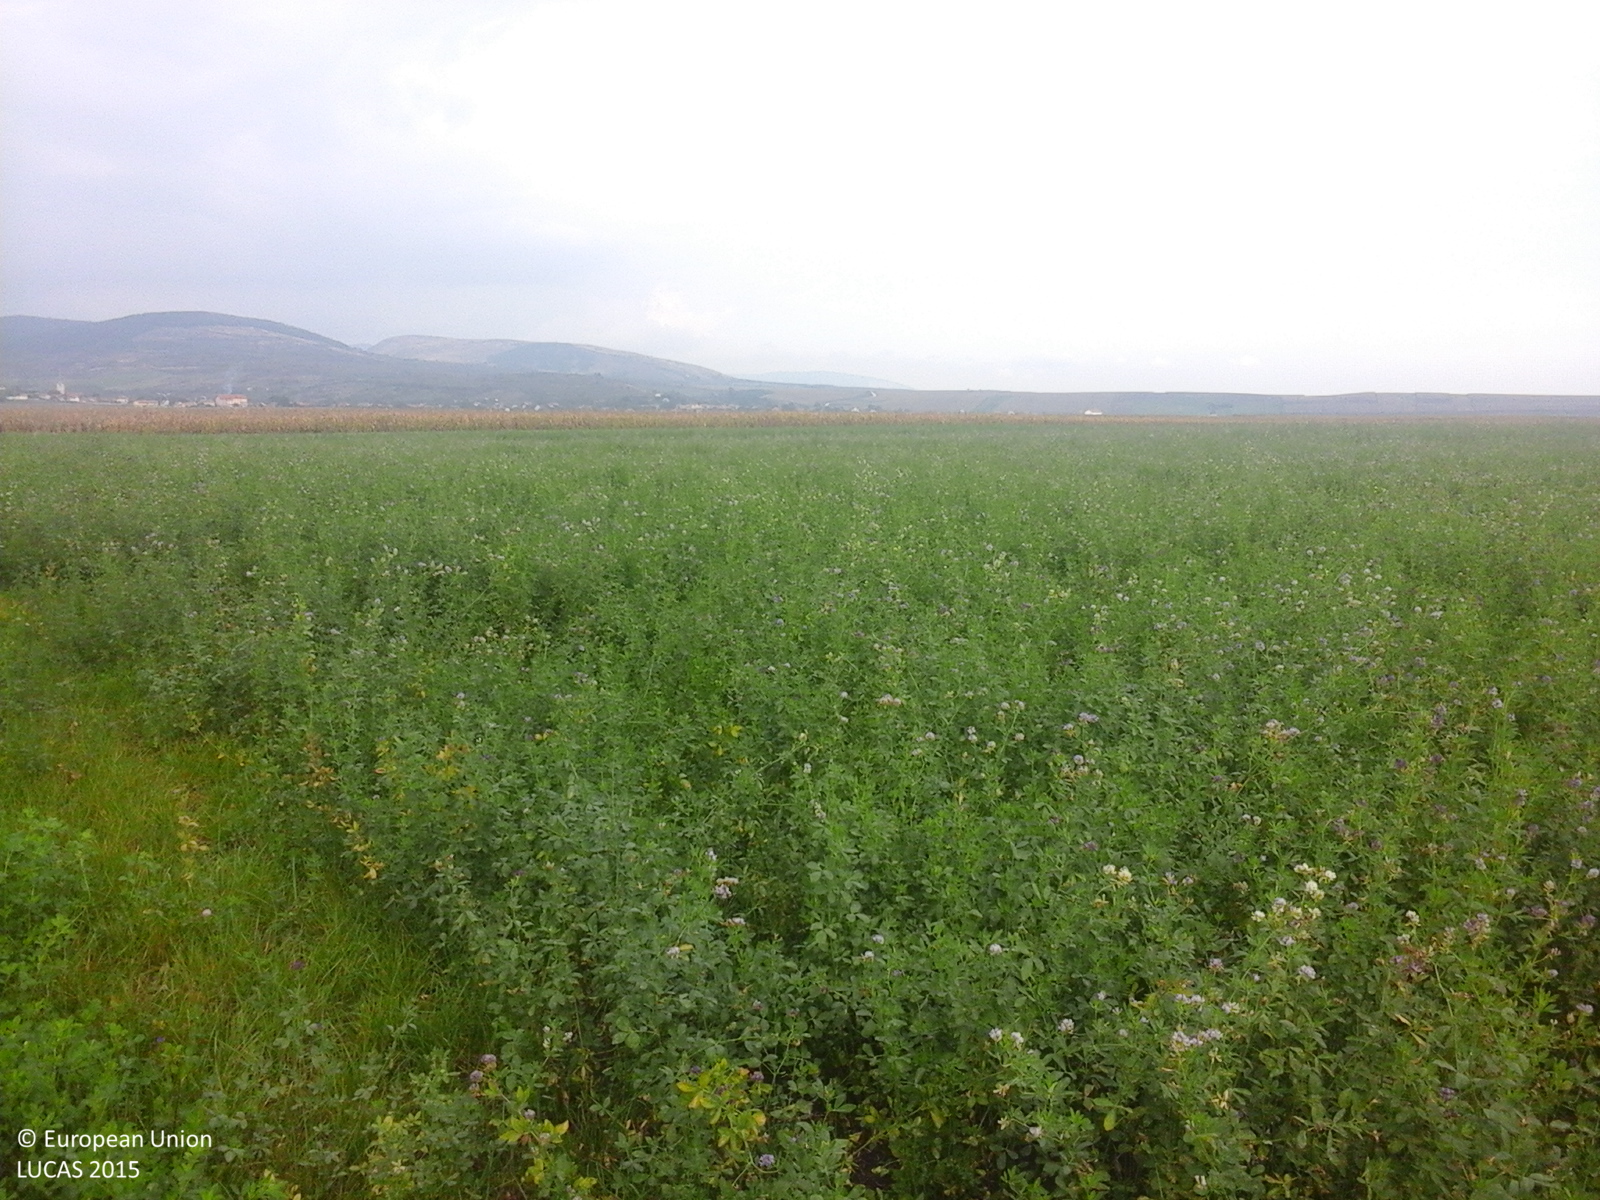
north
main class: Cropland
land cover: Lucerne
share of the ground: > 75 %
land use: Agriculture (excluding fallow land and kitchen gardens)
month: October
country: RO
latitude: 46.1567
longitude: 23.5726
